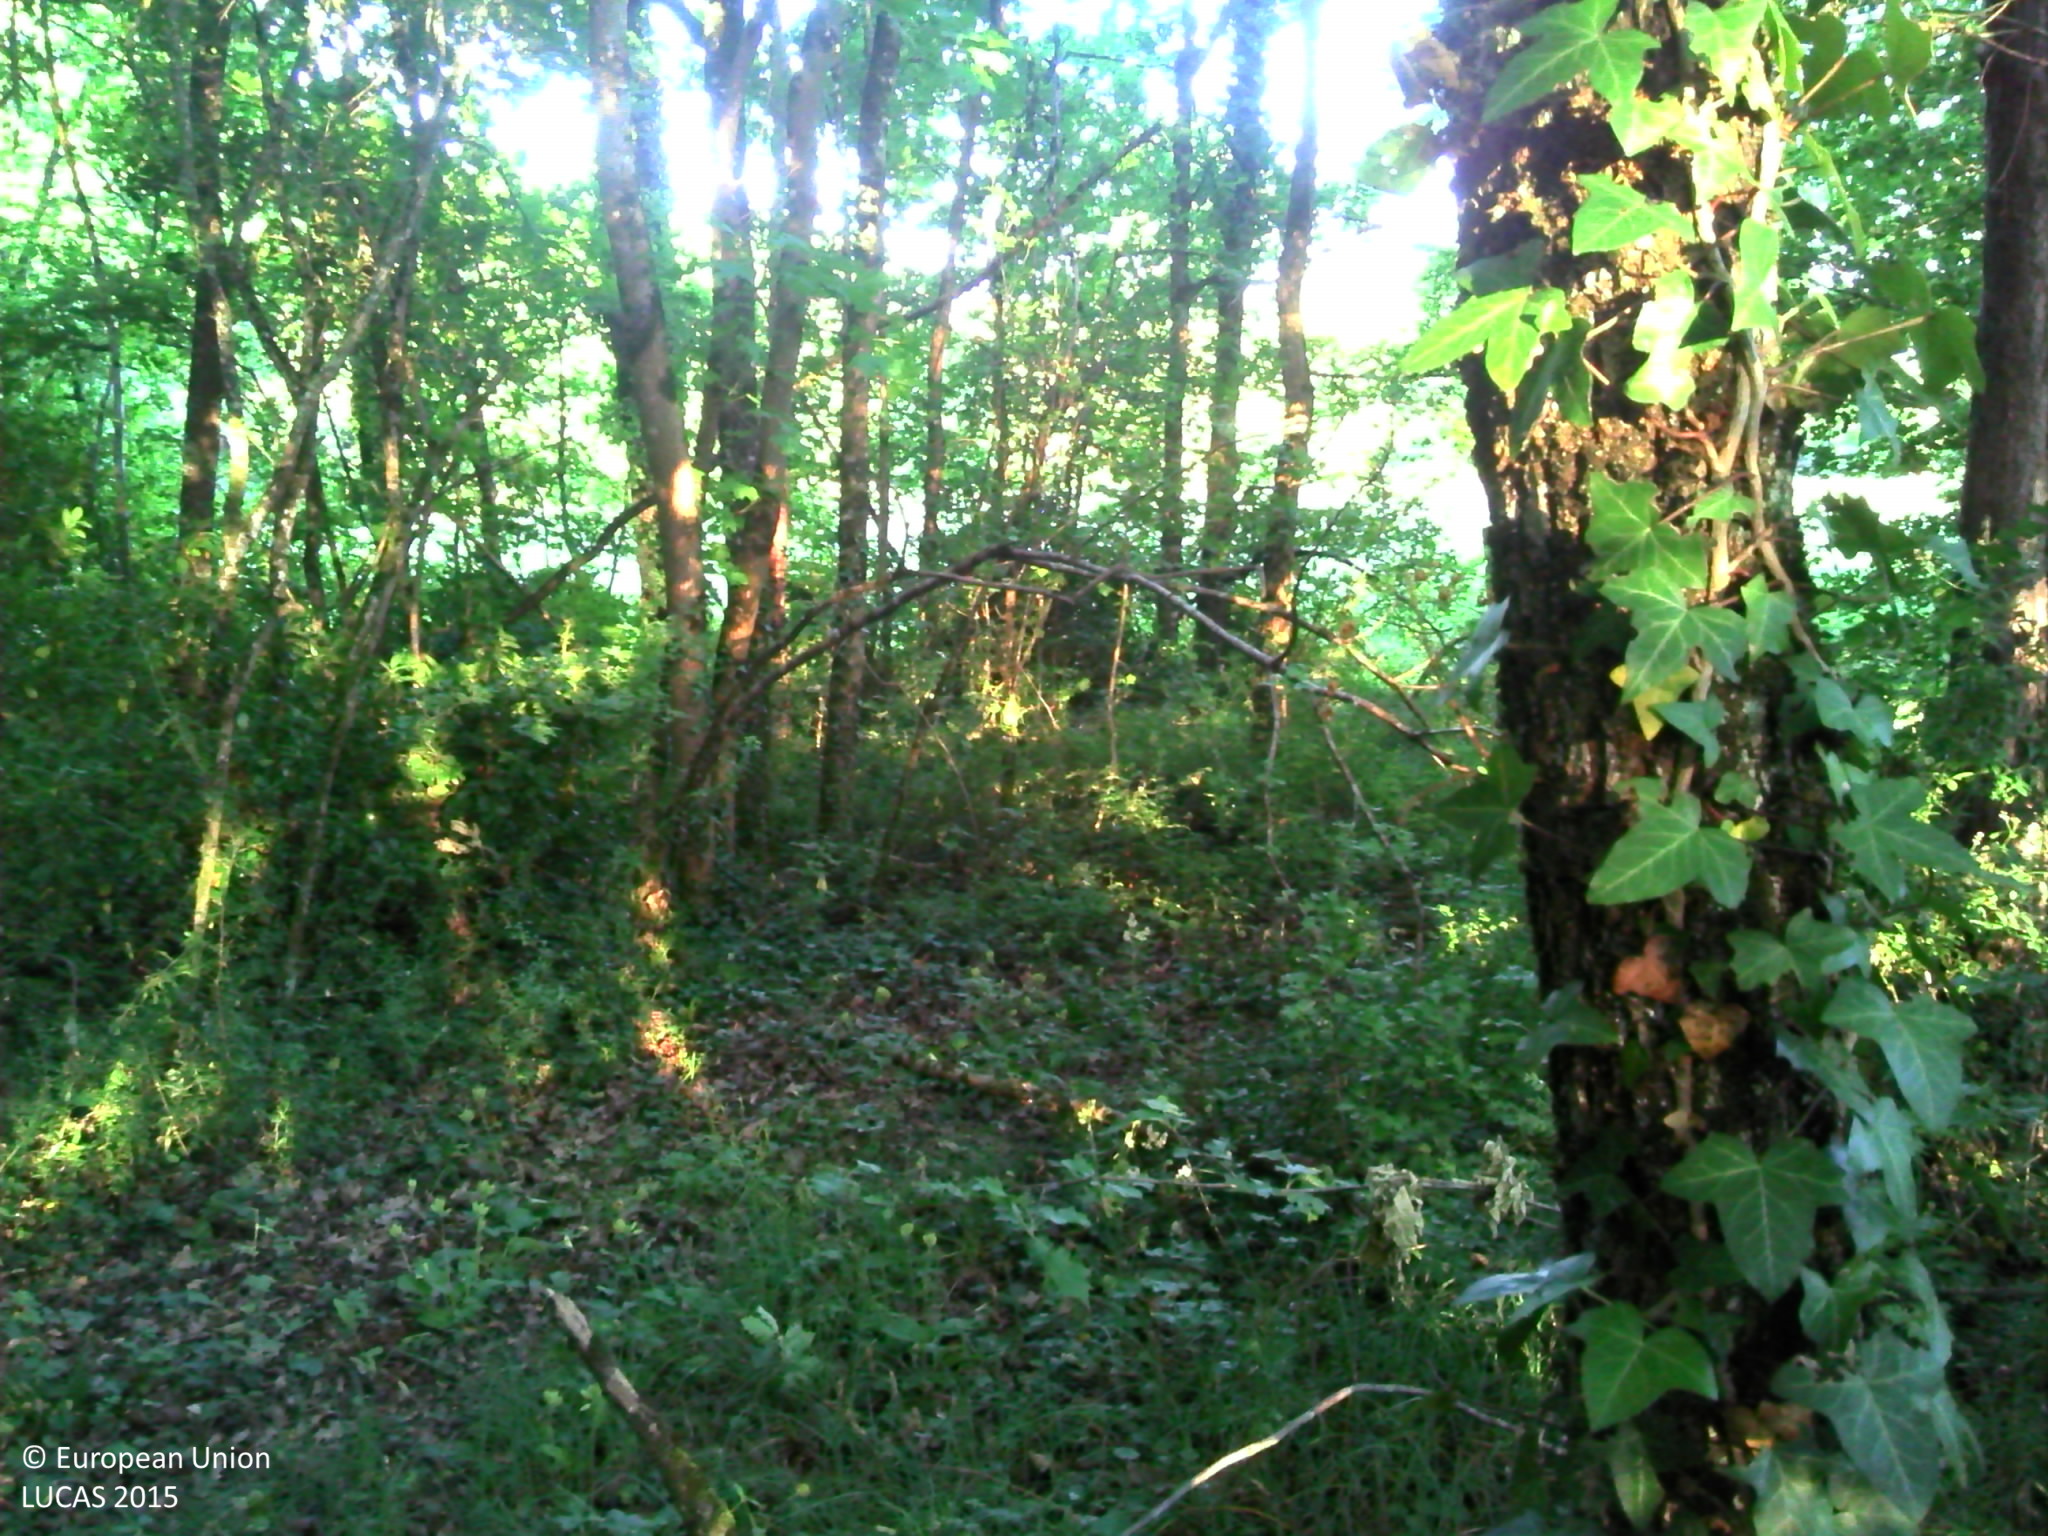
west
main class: Woodland
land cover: Broadleaved woodland
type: mesophytic deciduous forest
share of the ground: > 75 %
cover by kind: broadleaved forest trees 85 %, shrubs 10 %, herbaceous plants 5 %
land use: Forestry
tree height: > 5 m
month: June
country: FR
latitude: 46.6781
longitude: 0.5830
